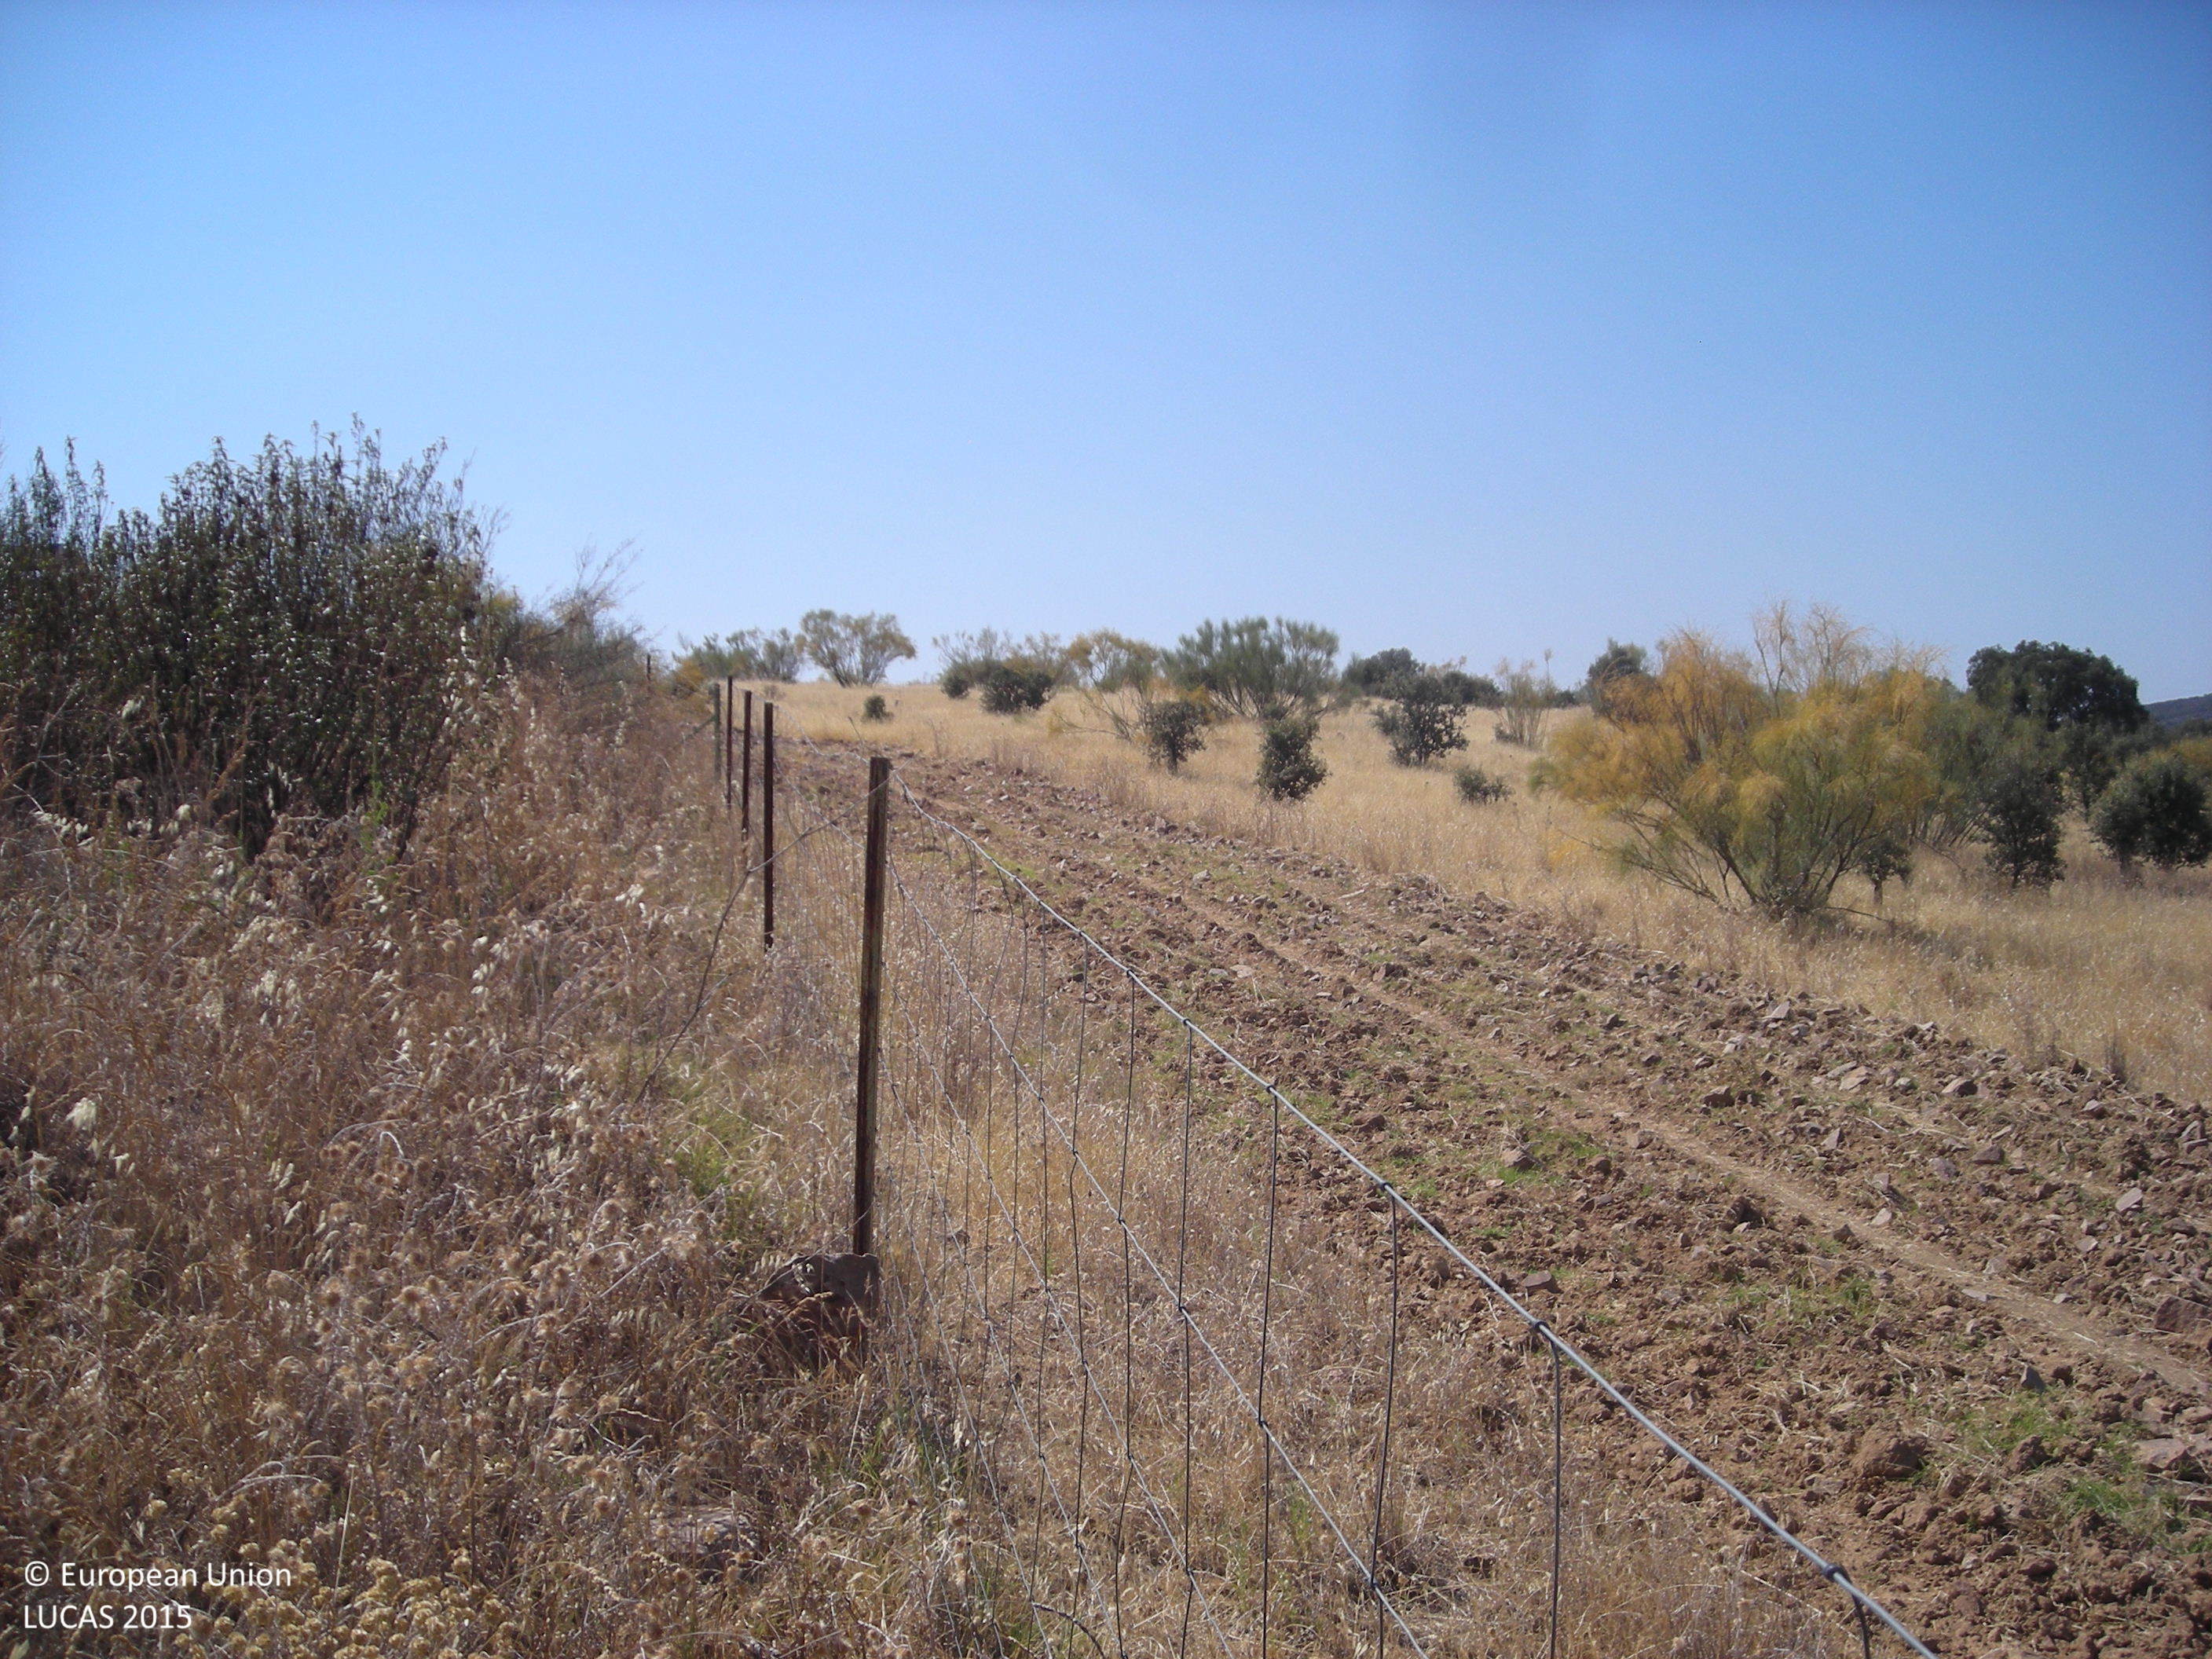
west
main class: Shrubland
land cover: Shrubland without tree cover
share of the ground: > 75 %
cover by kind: shrubs 100 %
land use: Semi-natural and natural areas not in use
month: July
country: ES
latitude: 38.6930
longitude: -5.8533
